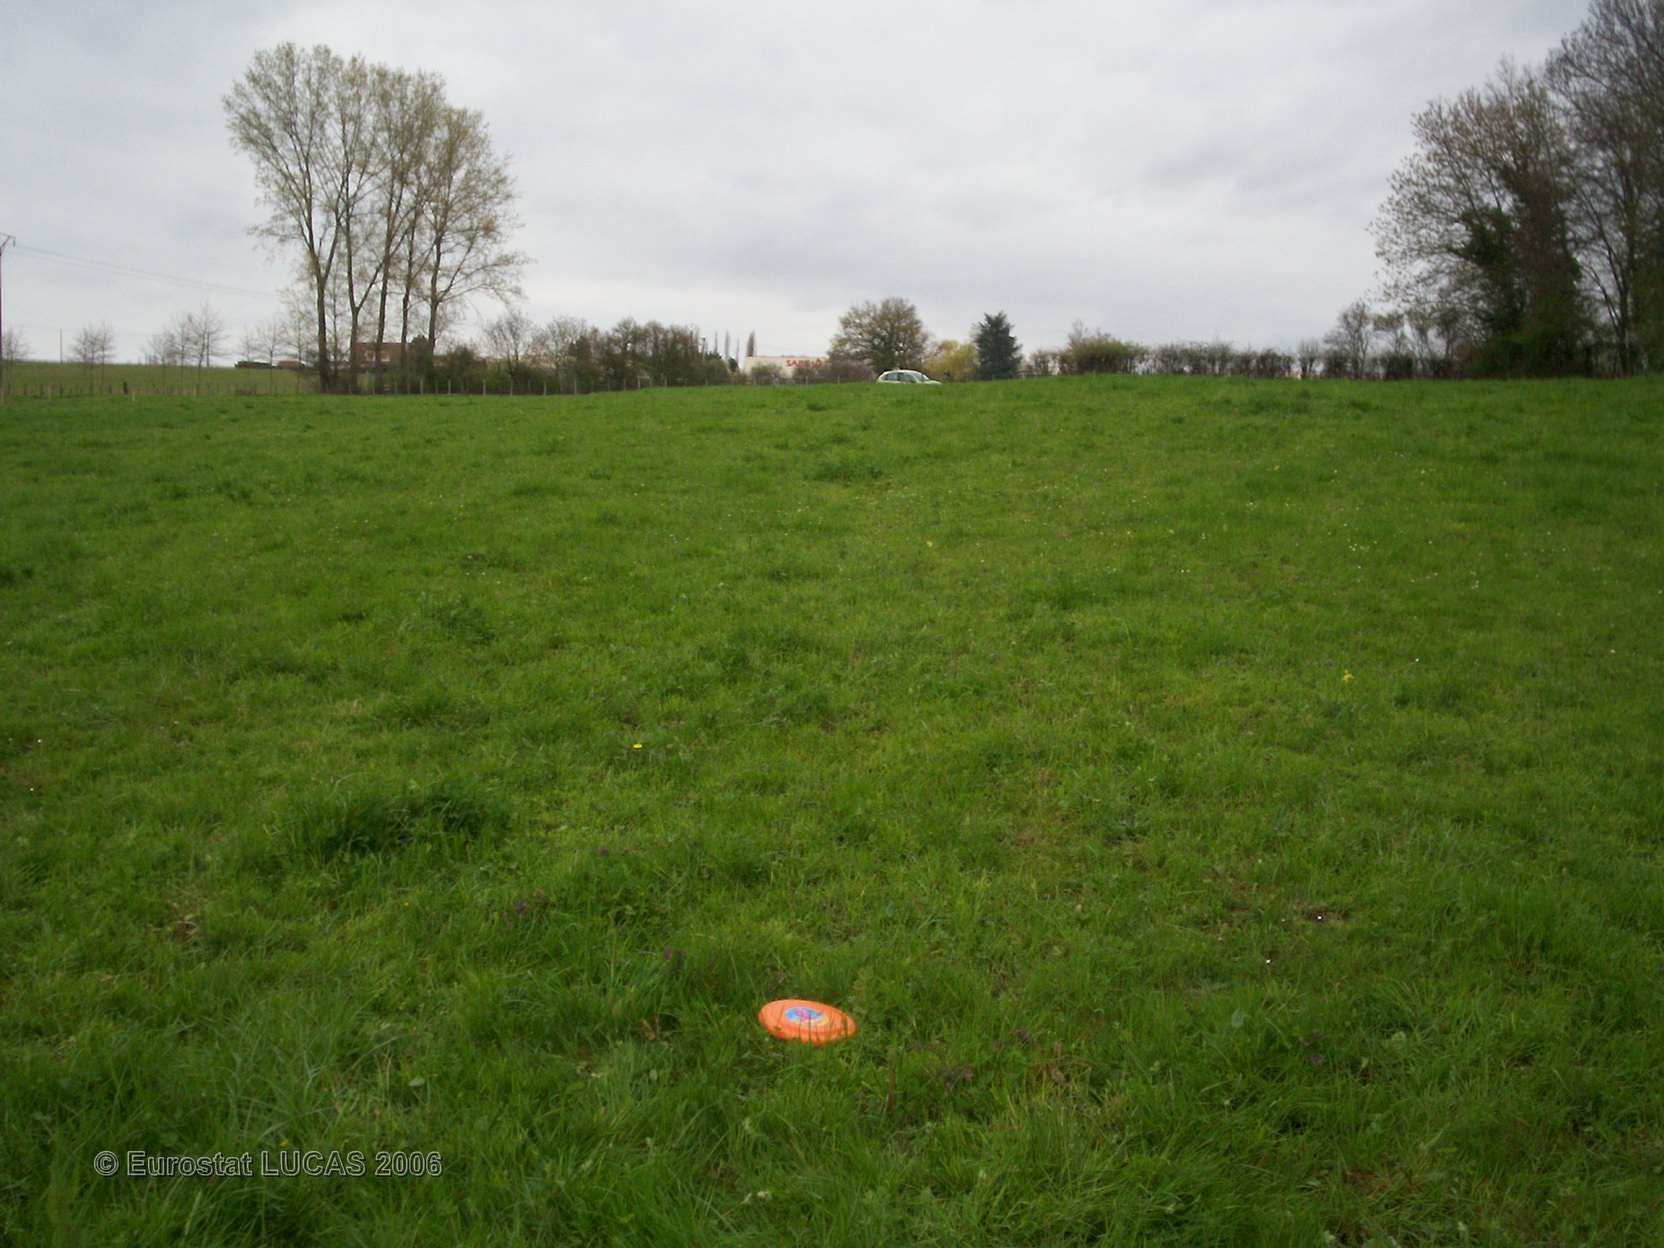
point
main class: Grassland
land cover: Grassland without tree/shrub cover
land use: Agriculture (excluding fallow land and kitchen gardens)
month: April
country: FR
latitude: 46.2416
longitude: 4.7759
